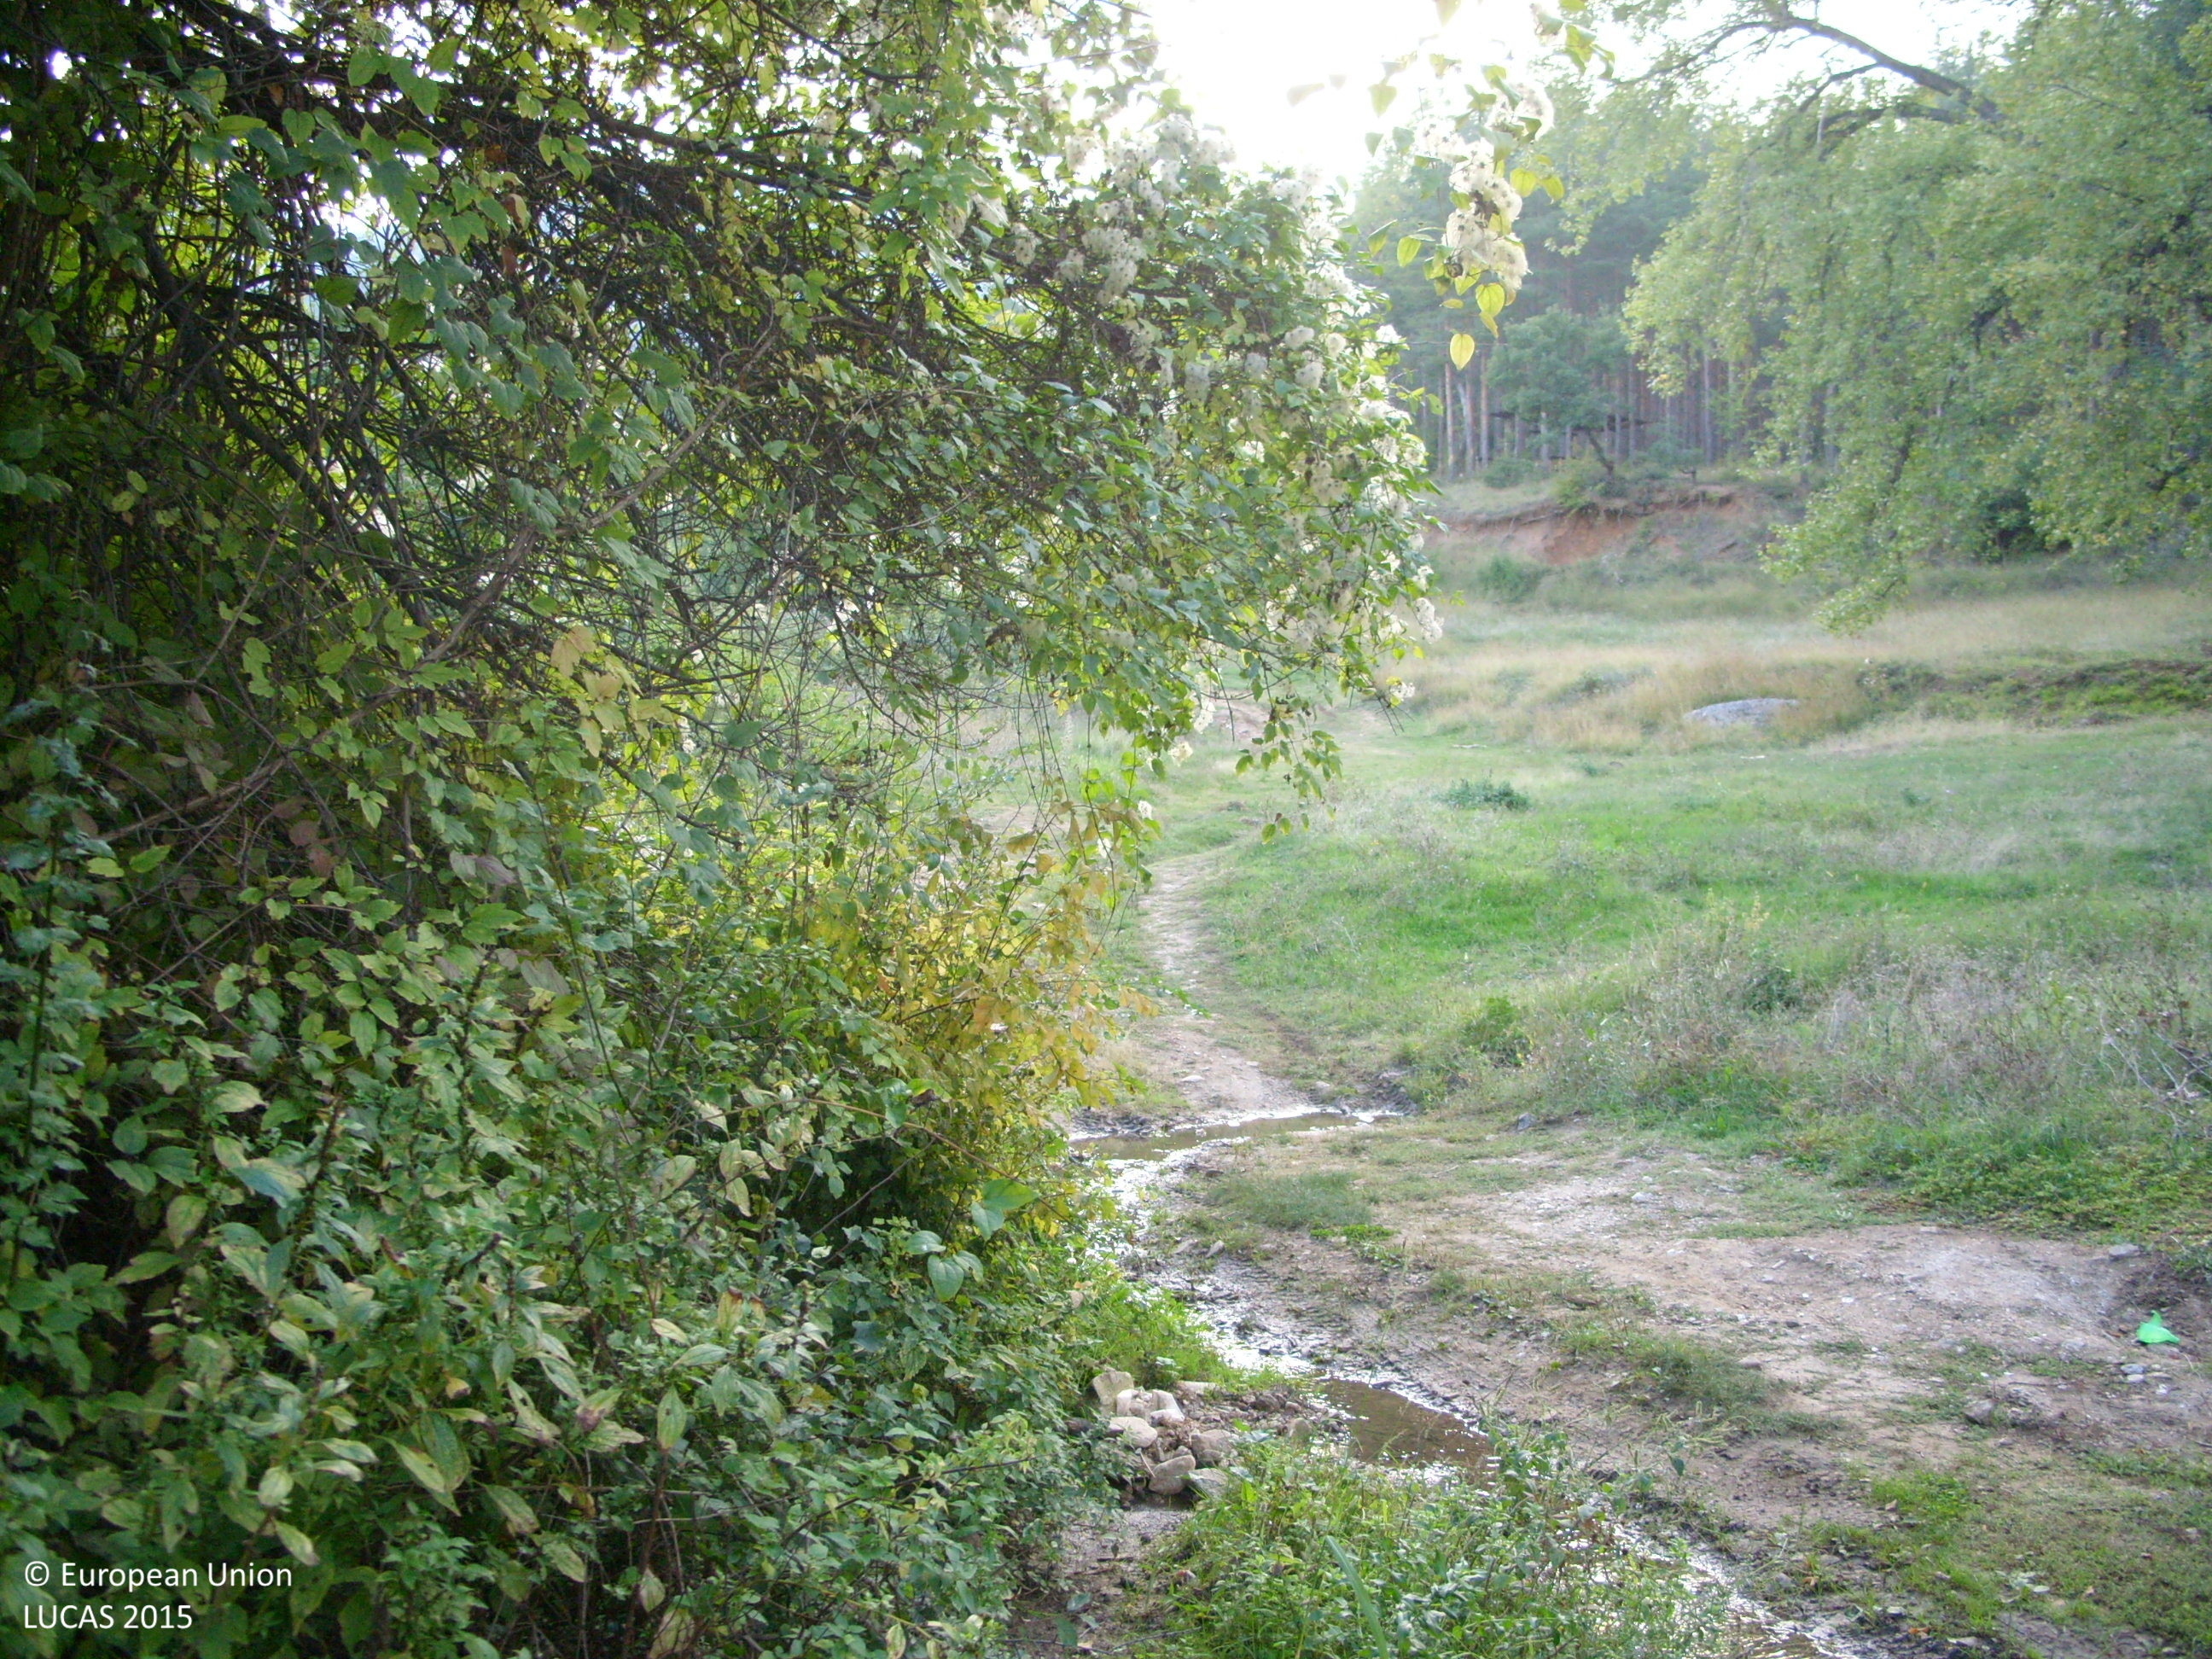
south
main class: Cropland
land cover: Other fruit trees and berries
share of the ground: 25 - 50 %
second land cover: Grassland without tree/shrub cover
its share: > 75 %
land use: Kitchen garden
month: October
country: BG
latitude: 42.1752
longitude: 24.0958
